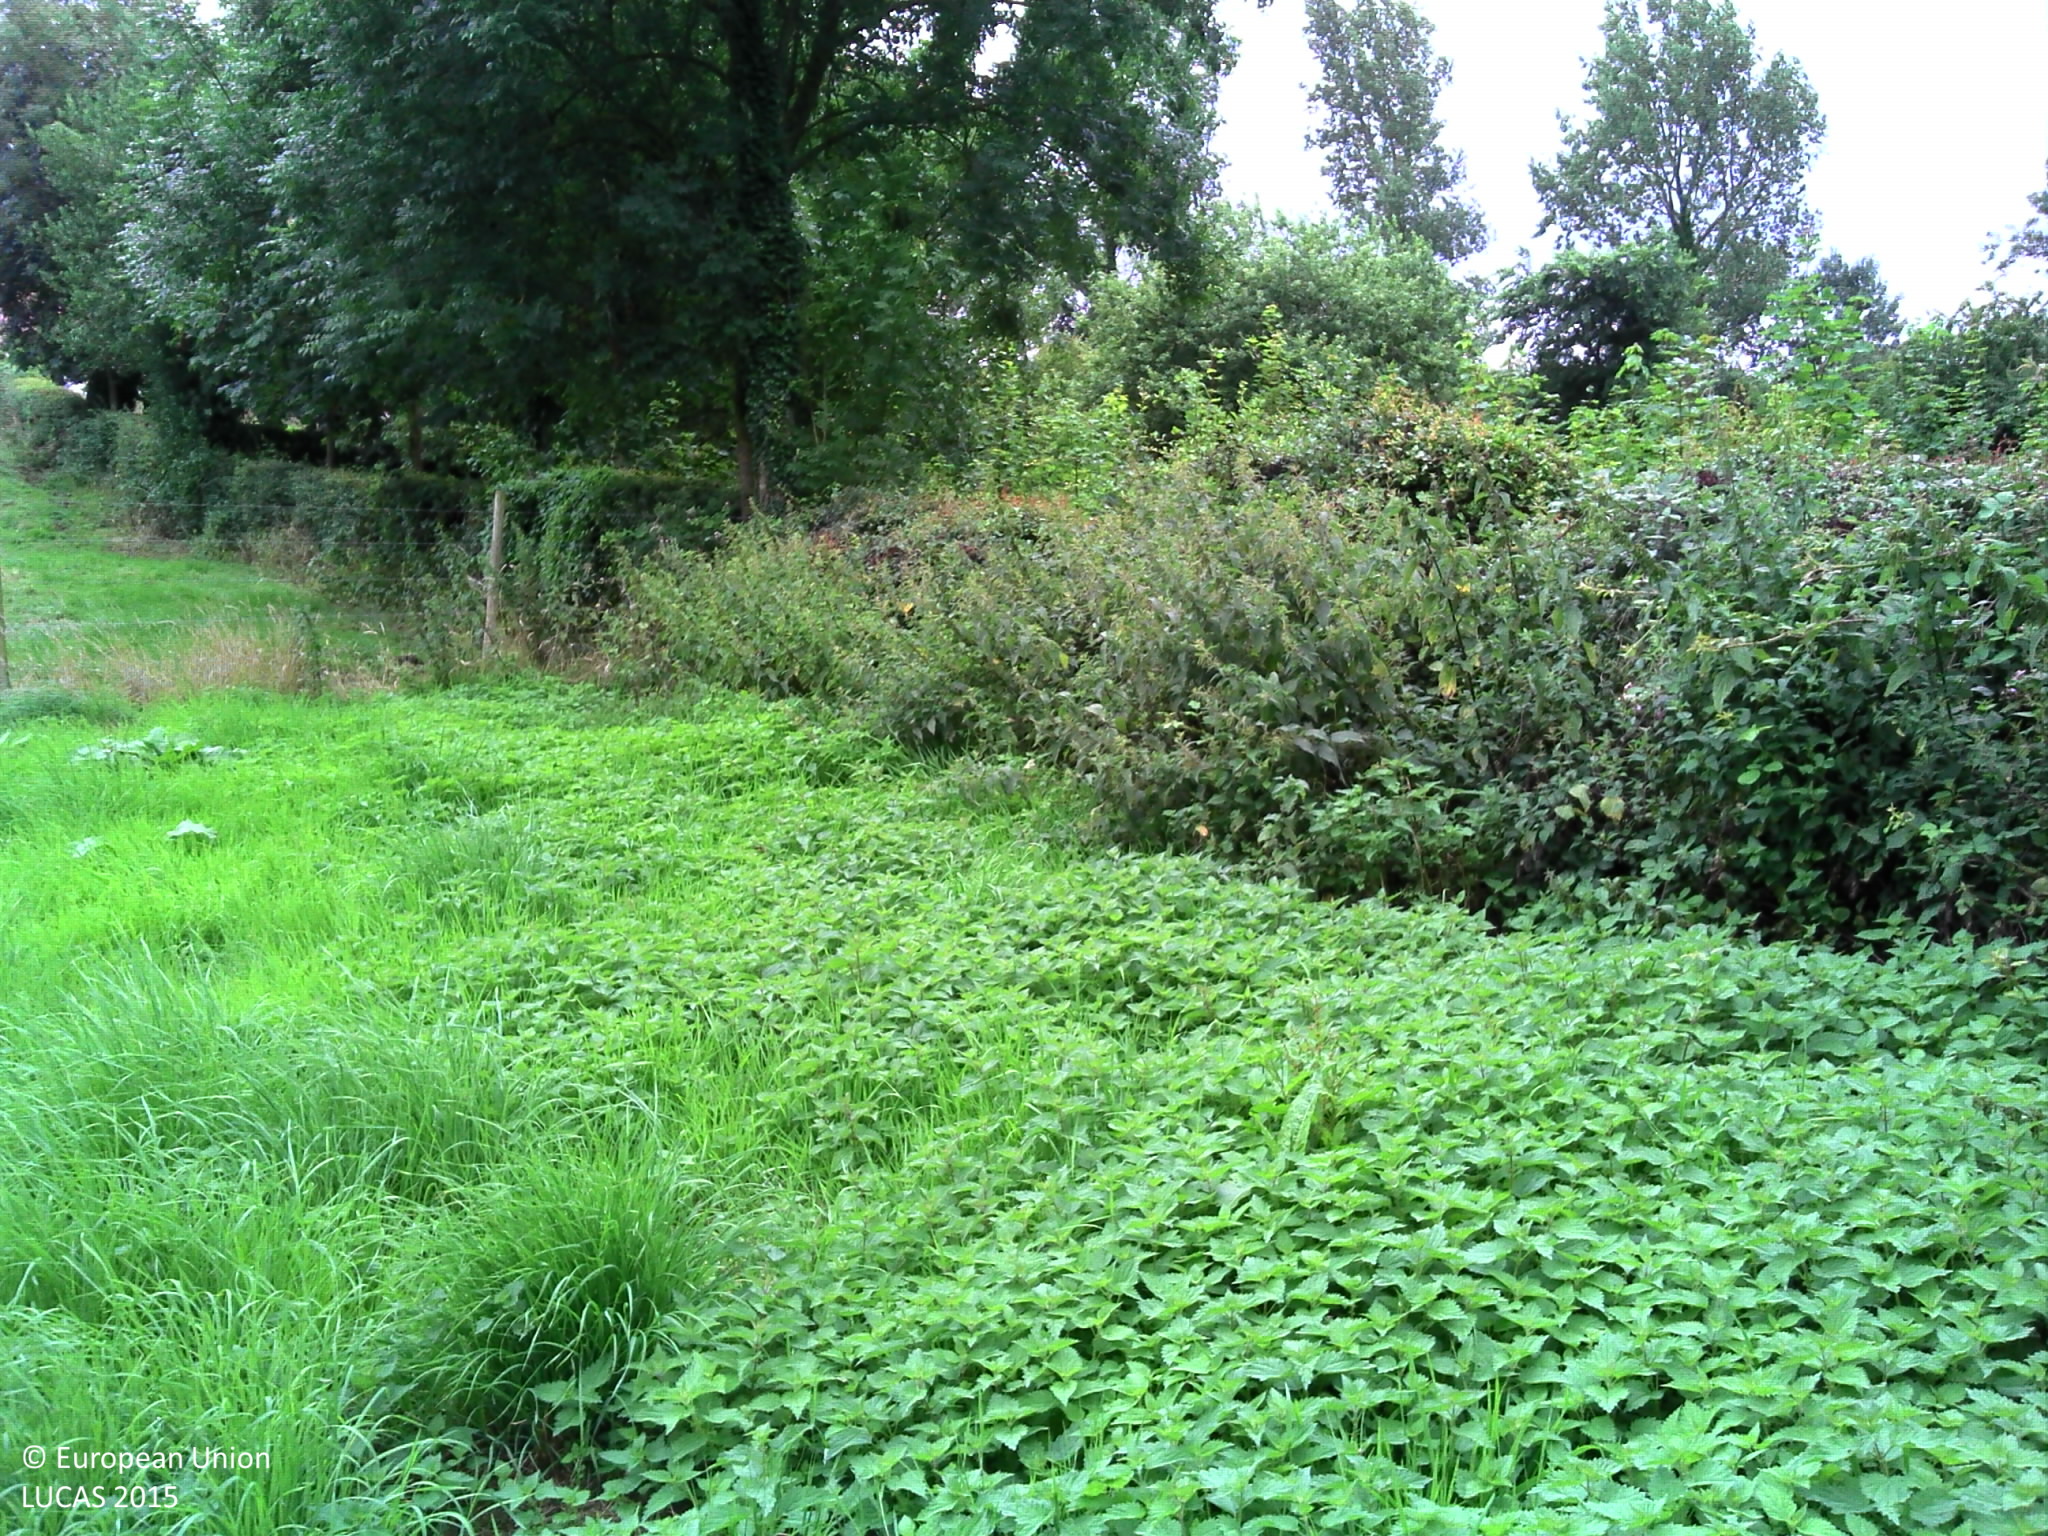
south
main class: Grassland
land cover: Grassland without tree/shrub cover
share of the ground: > 75 %
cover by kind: herbaceous plants 95 %
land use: Agriculture (excluding fallow land and kitchen gardens)
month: July
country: FR
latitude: 50.6671
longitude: 2.0757
